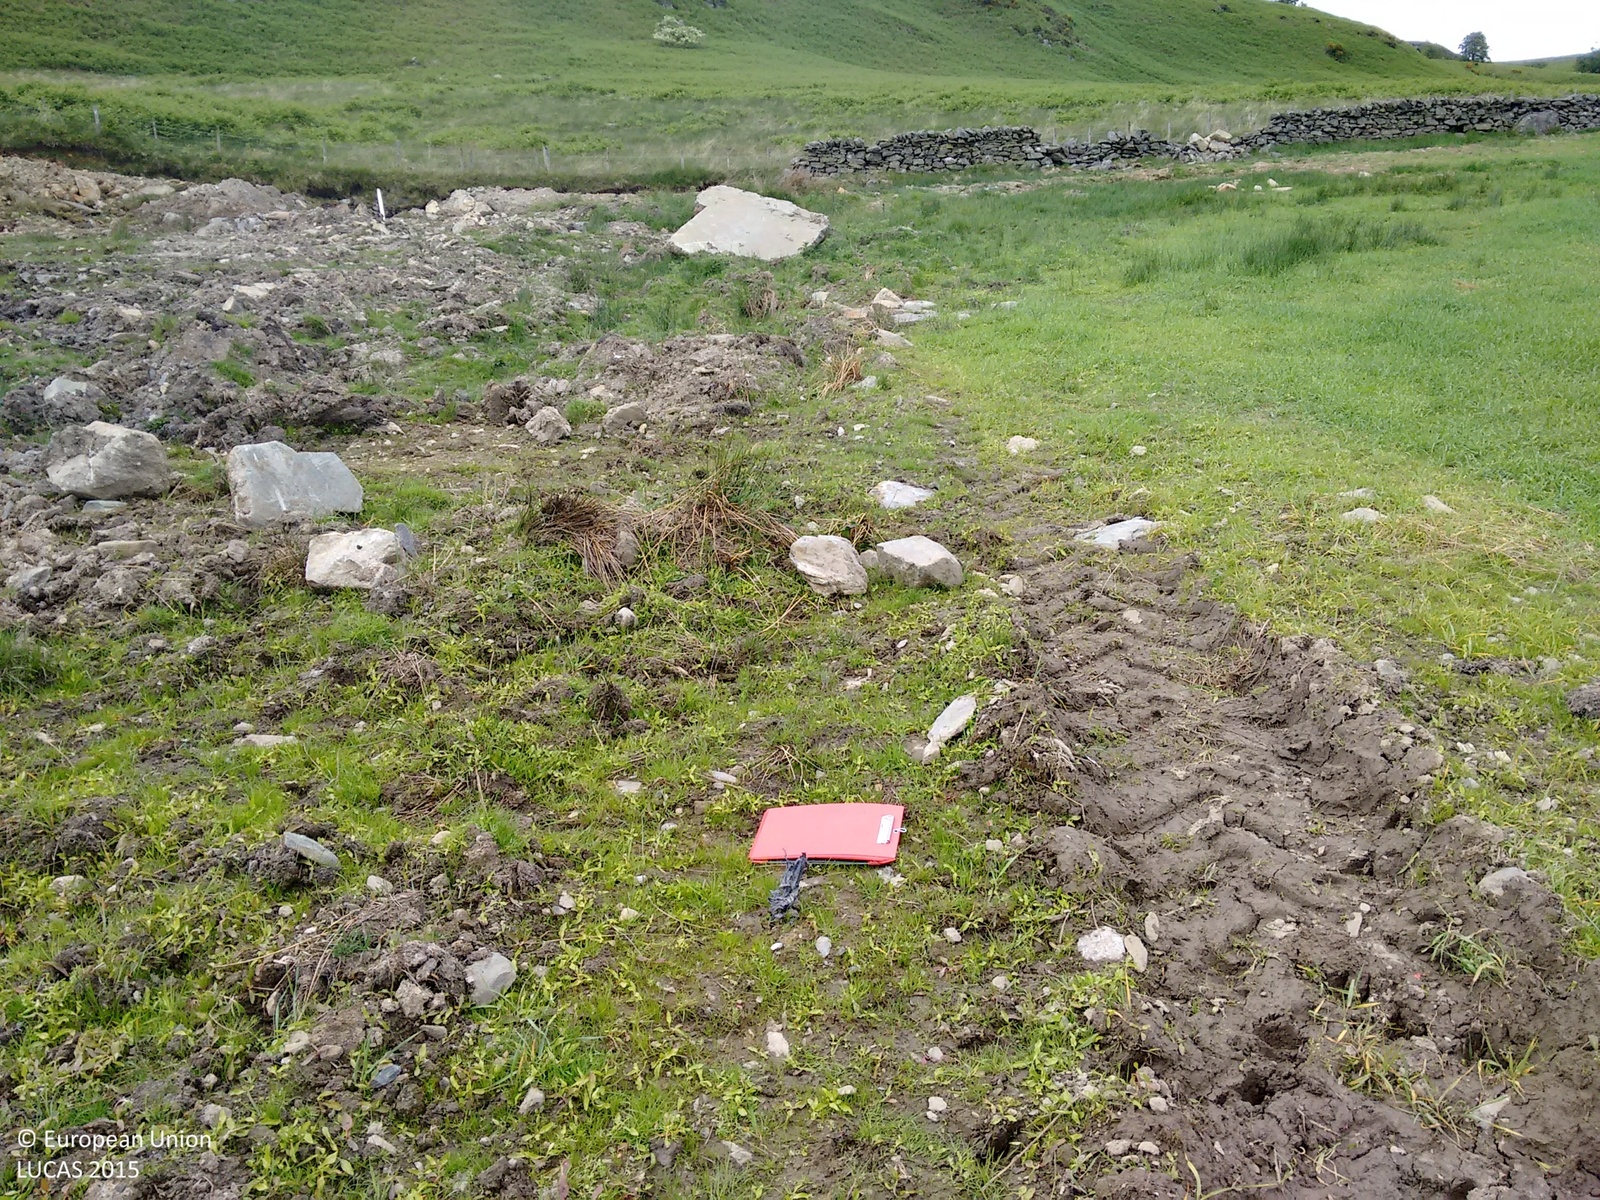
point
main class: Grassland
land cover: Grassland without tree/shrub cover
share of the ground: > 75 %
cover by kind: unconsolidated bare surface 70 %, herbaceous plants 30 %
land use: Agriculture (excluding fallow land and kitchen gardens)
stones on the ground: 25 - 50 %
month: June
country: GB
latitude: 56.5203
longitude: -3.5837
